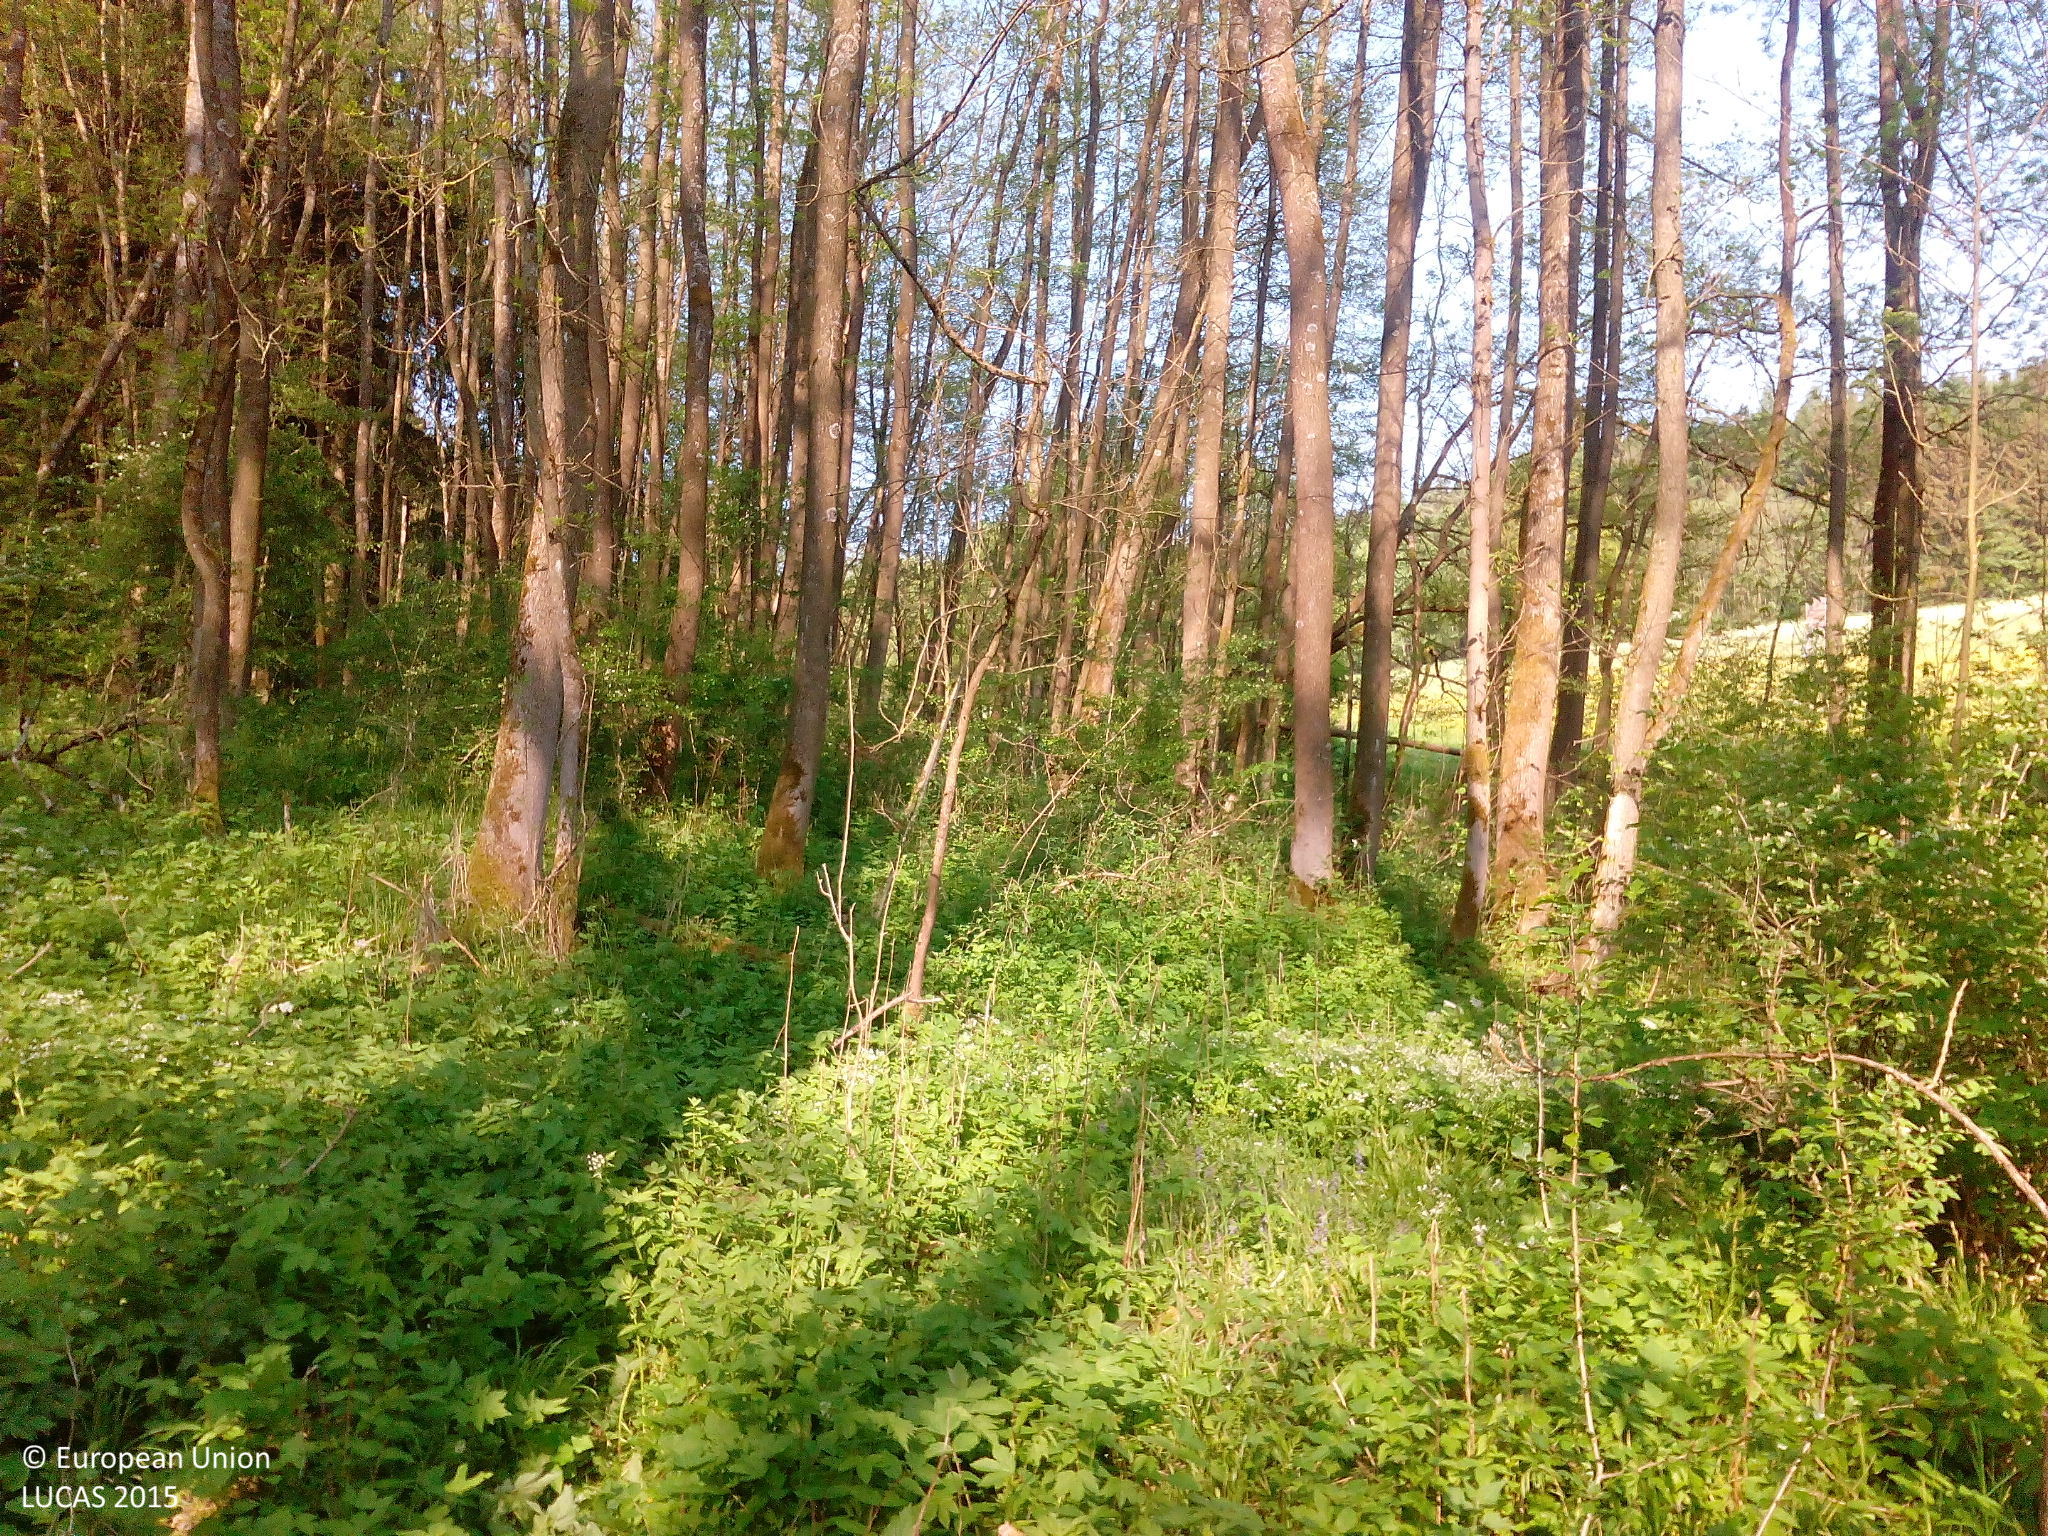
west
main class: Woodland
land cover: Broadleaved woodland
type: mesophytic deciduous forest
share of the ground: > 75 %
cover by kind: broadleaved forest trees 90 %, shrubs 5 %, herbaceous plants 5 %
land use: Forestry
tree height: > 5 m
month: May
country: DE
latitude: 49.8688
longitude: 11.4883
